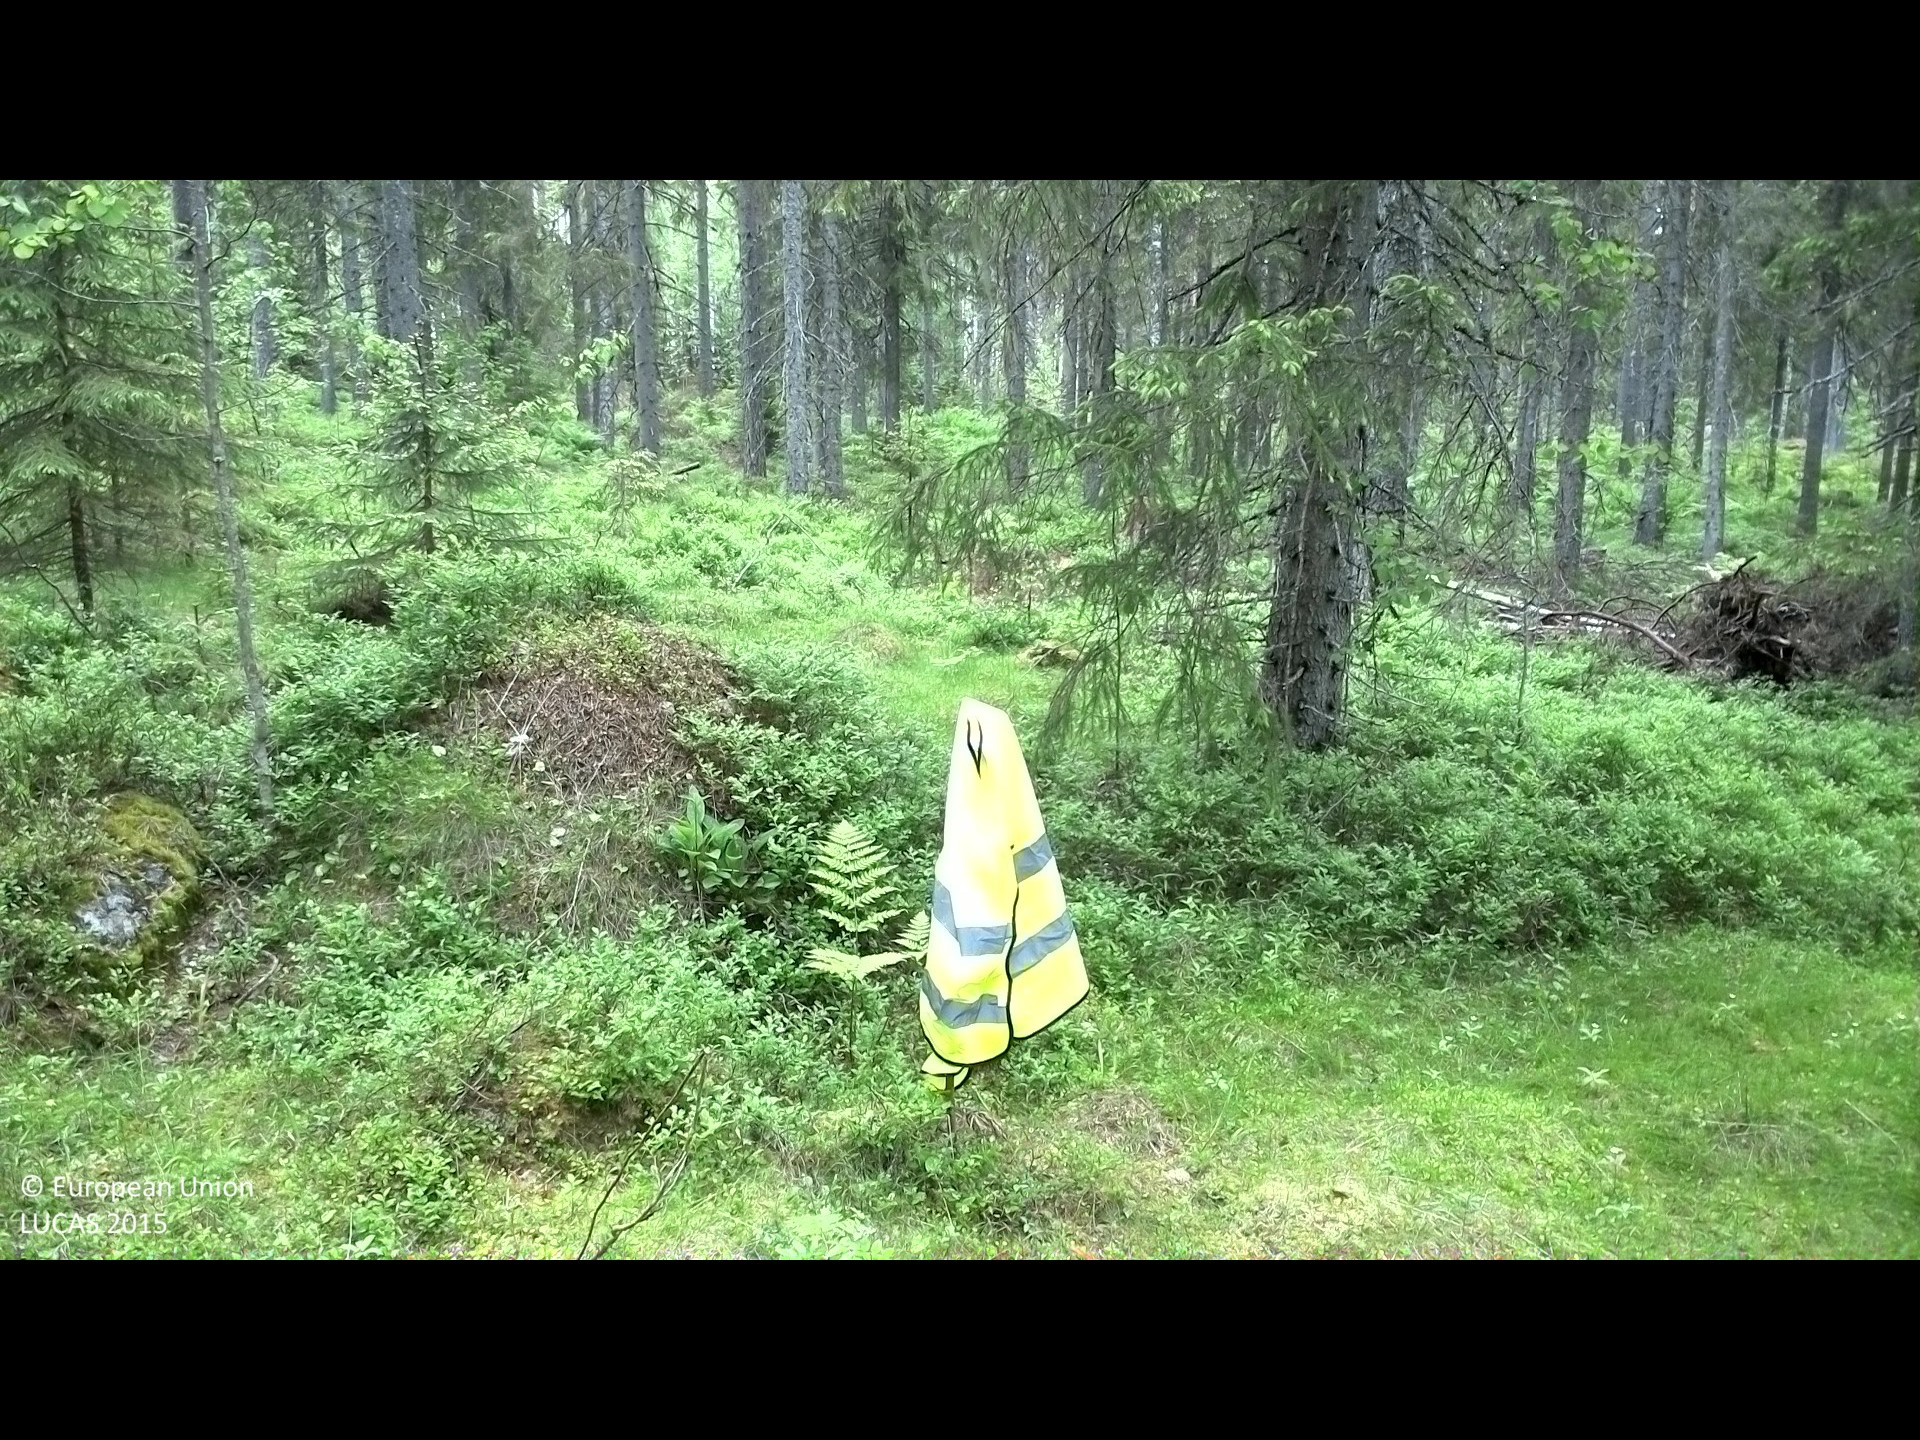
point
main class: Woodland
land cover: Spruce dominated coniferous woodland
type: boreal forest
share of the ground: 25 - 50 %
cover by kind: shrubs 40 %, coniferous forest trees 35 %, herbaceous plants 15 %, broadleaved forest trees 5 %, lichens and mosses 5 %
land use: Forestry
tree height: > 5 m
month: June
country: SE
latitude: 61.9472
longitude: 16.9014
